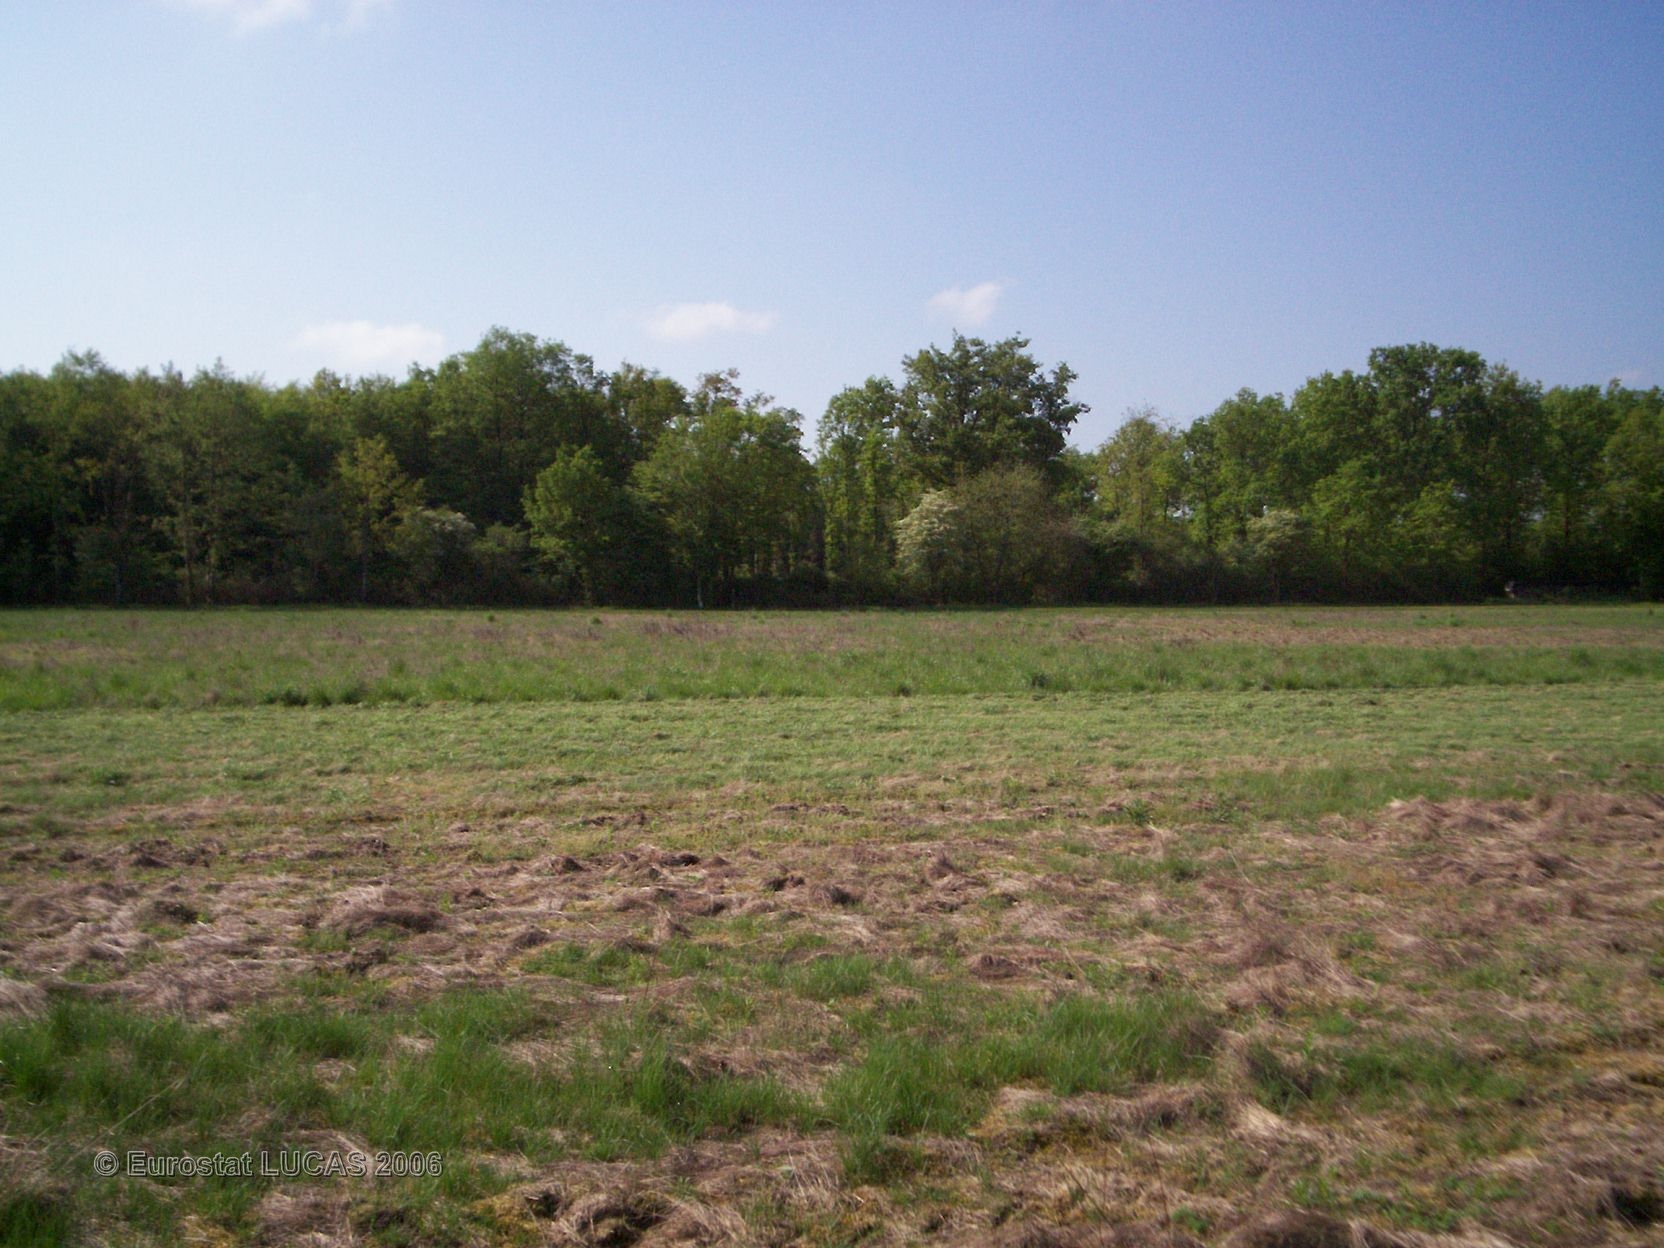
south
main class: Cropland
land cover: Common wheat
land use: Agriculture (excluding fallow land and kitchen gardens)
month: May
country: FR
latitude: 47.4109
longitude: 0.2625
